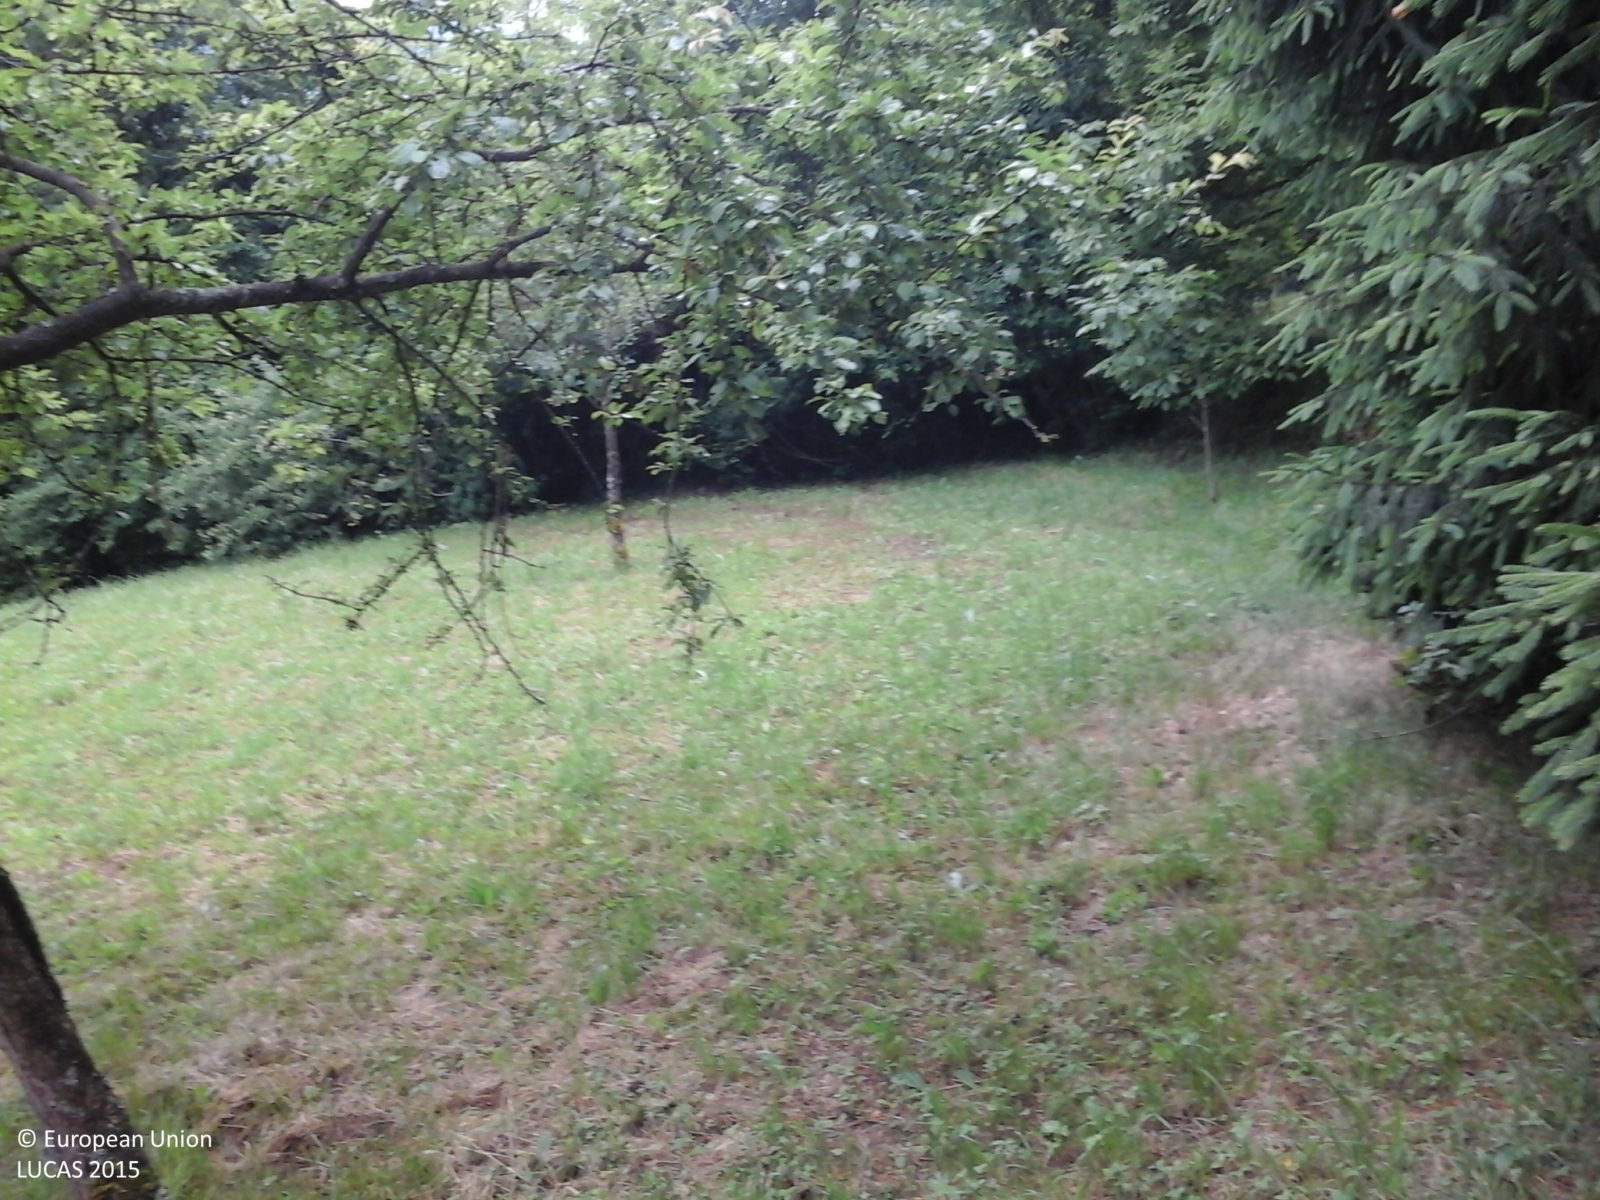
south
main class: Grassland
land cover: Grassland with sparse tree/shrub cover
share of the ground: > 75 %
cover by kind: herbaceous plants 85 %, shrubs 10 %, coniferous forest trees 5 %
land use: Residential
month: June
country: IT
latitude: 46.1280
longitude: 12.3138
